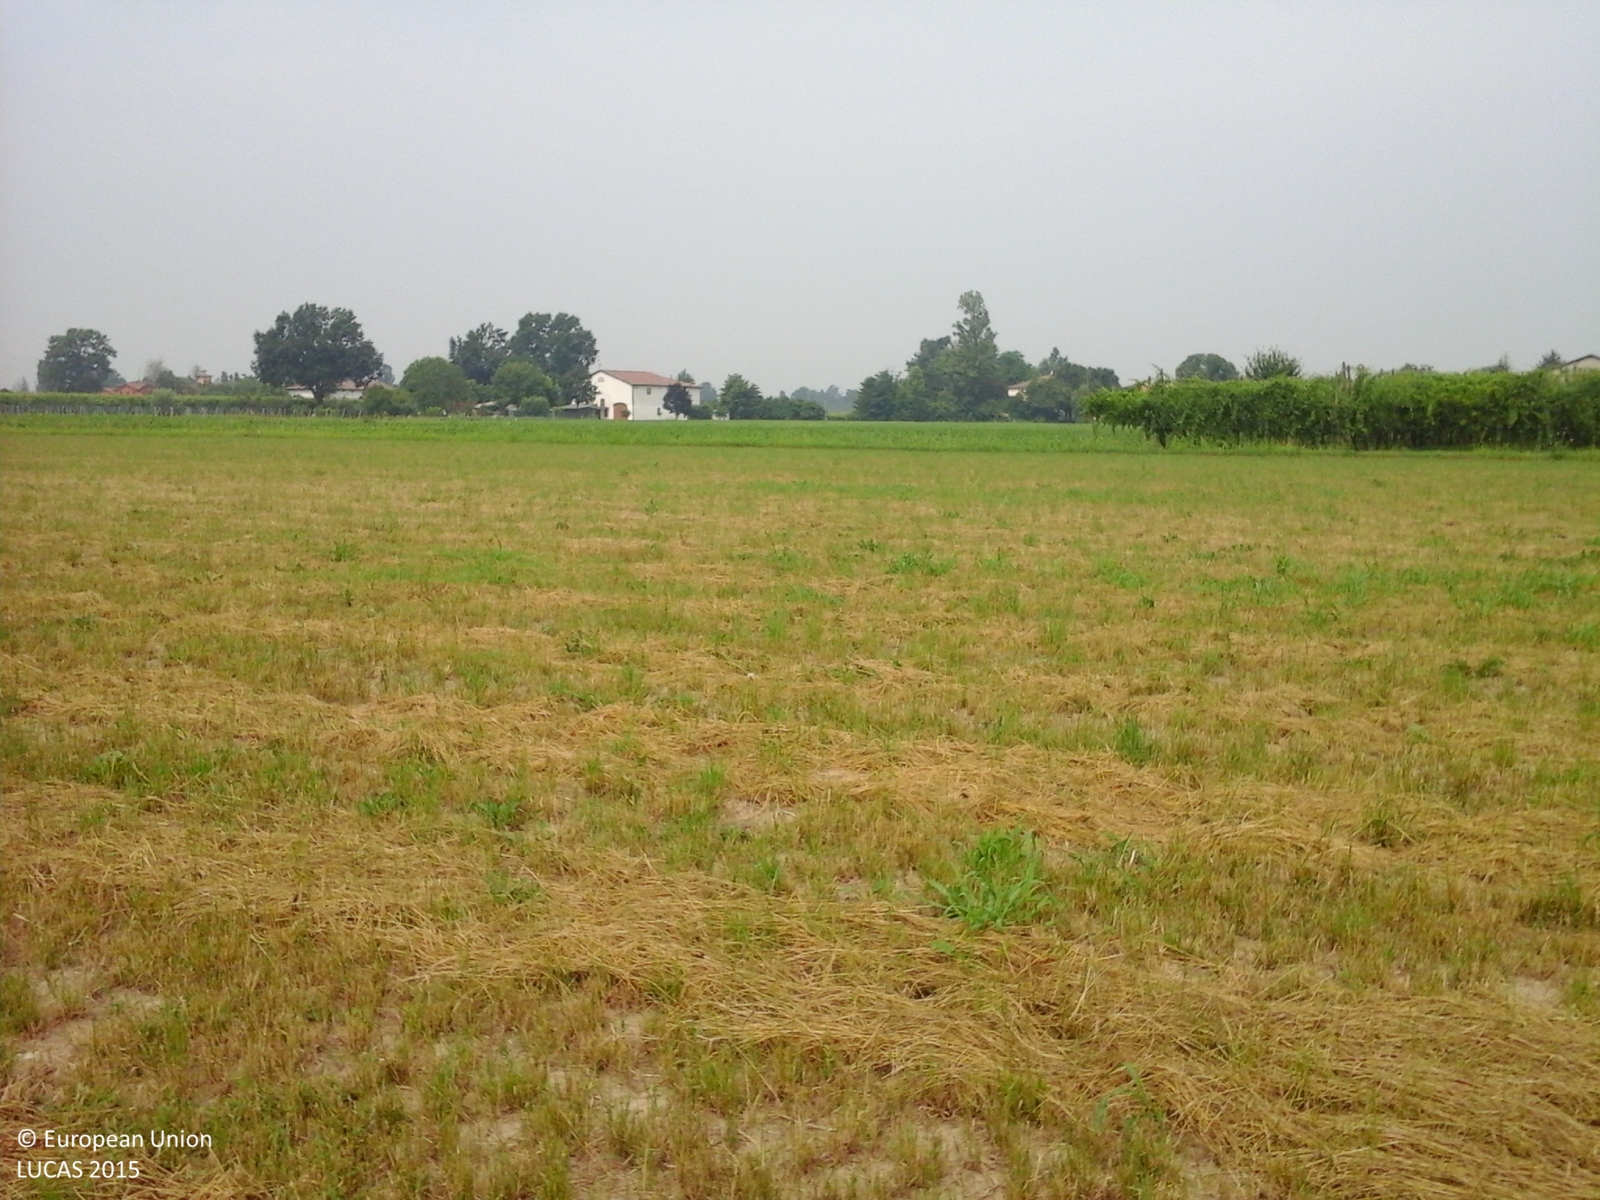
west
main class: Grassland
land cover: Grassland without tree/shrub cover
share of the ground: > 75 %
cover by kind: herbaceous plants 100 %
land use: Agriculture (excluding fallow land and kitchen gardens)
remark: Harvested field
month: June
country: IT
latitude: 44.7248
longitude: 10.9701
